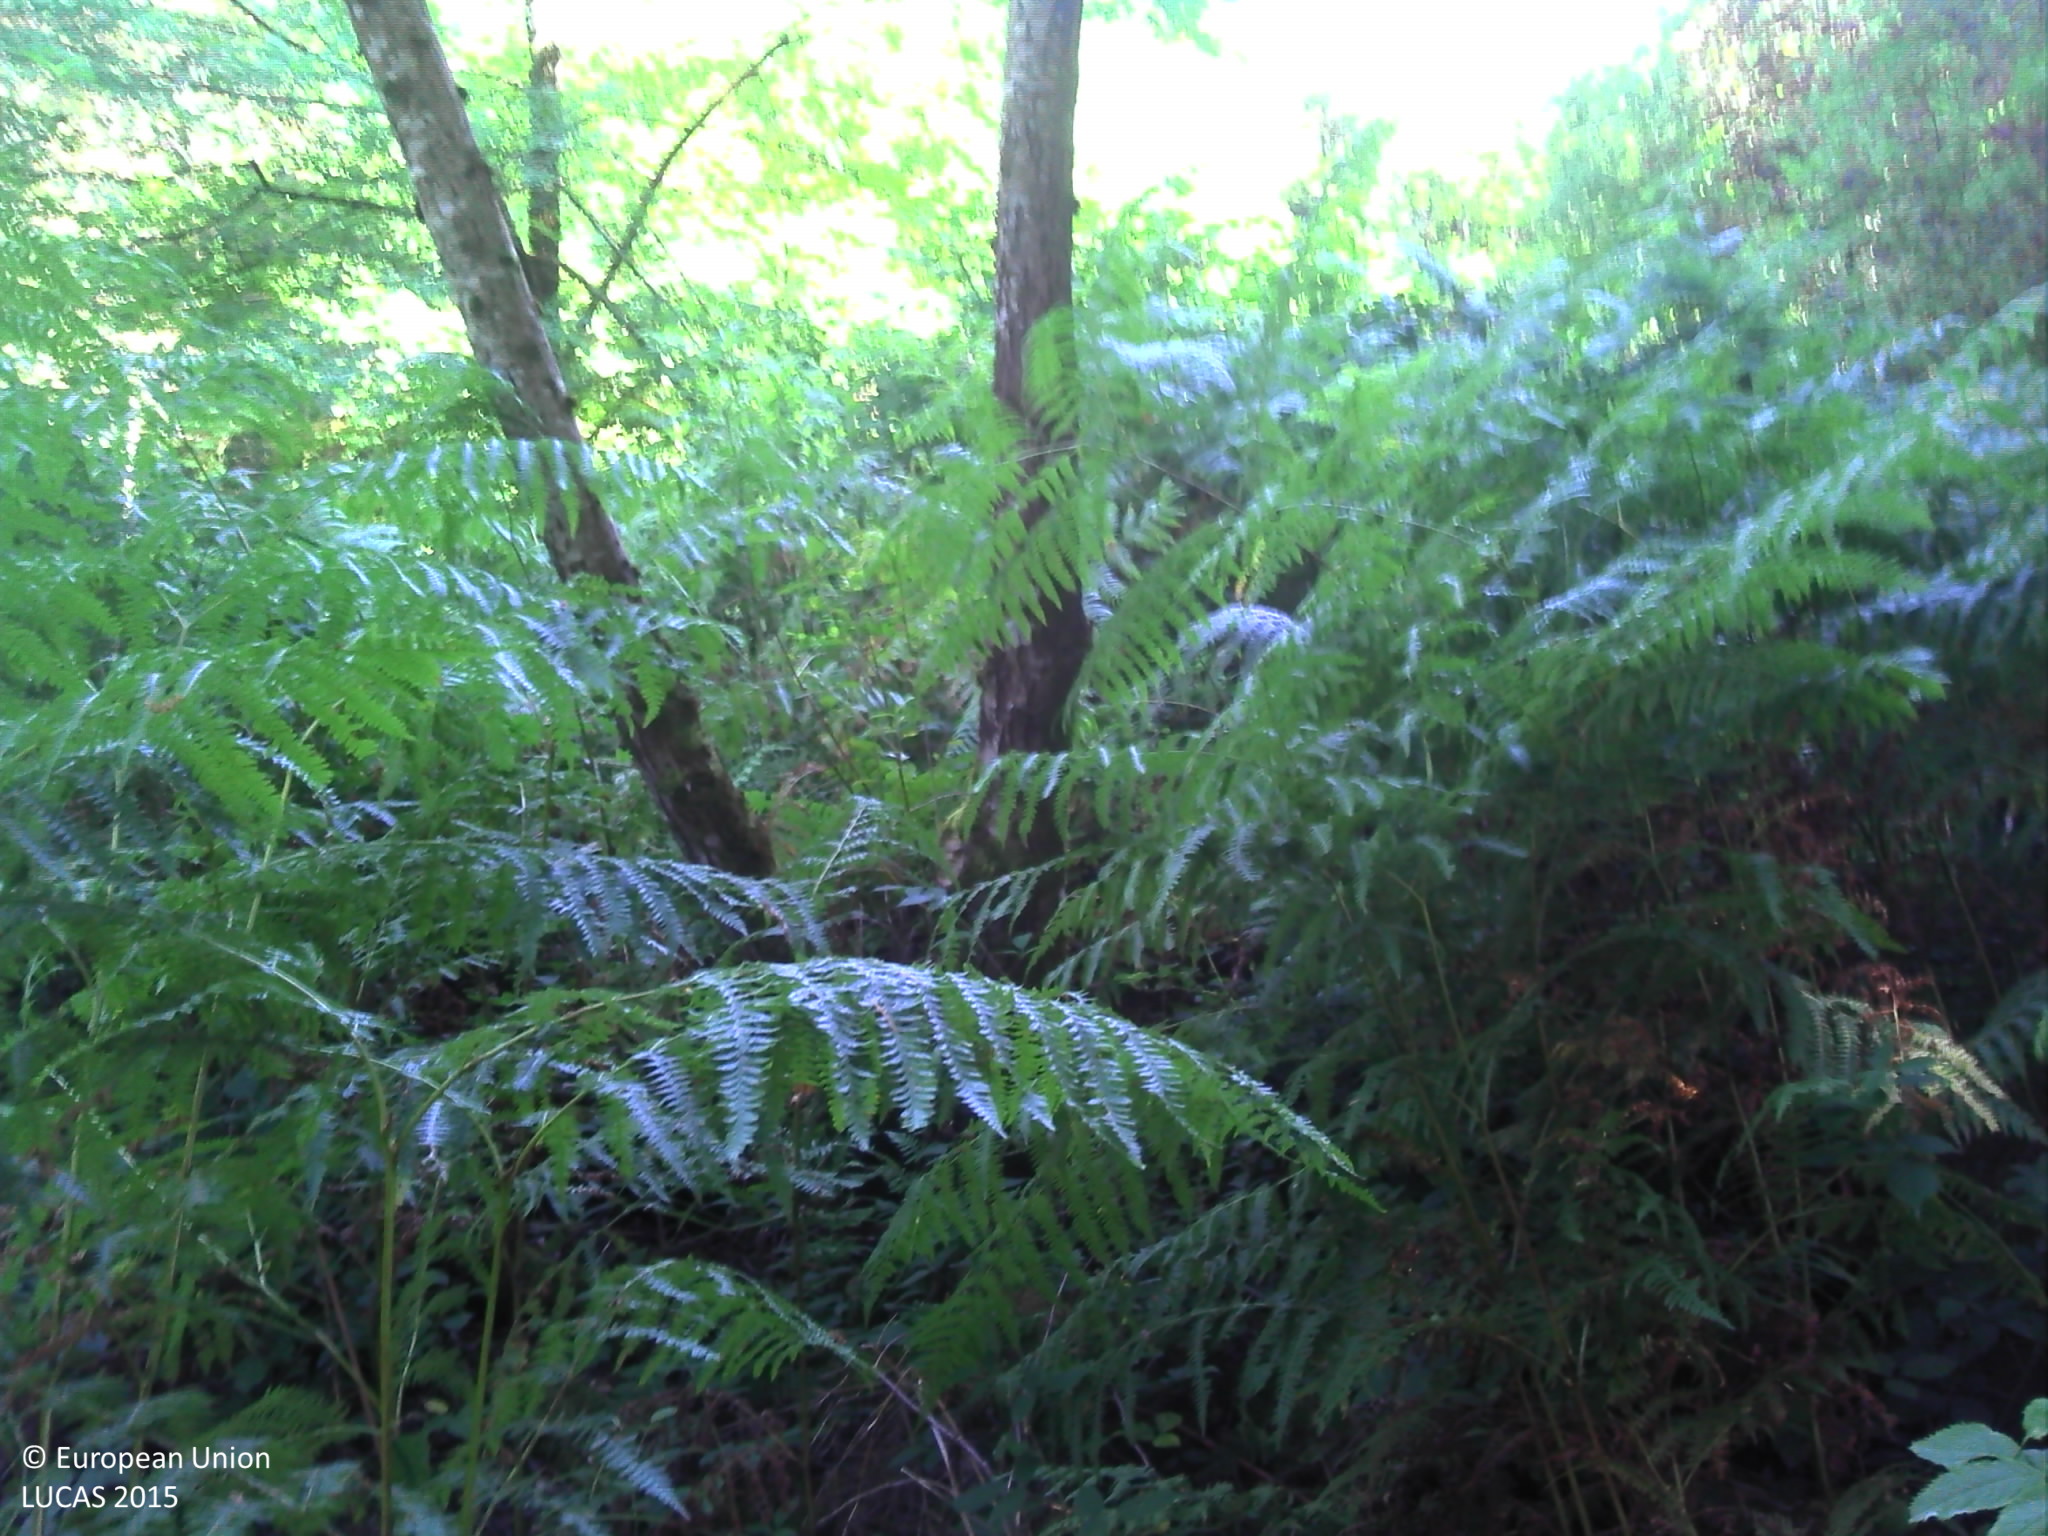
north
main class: Woodland
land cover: Spruce dominated coniferous woodland
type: hemiboreal forest and nemoral coniferous forest and mixed broadleaved-coniferous forest
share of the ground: > 75 %
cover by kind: coniferous forest trees 95 %, broadleaved forest trees 5 %
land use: Semi-natural and natural areas not in use
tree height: > 5 m
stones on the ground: < 10 %
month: August
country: FR
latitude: 46.0046
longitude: 1.4035
